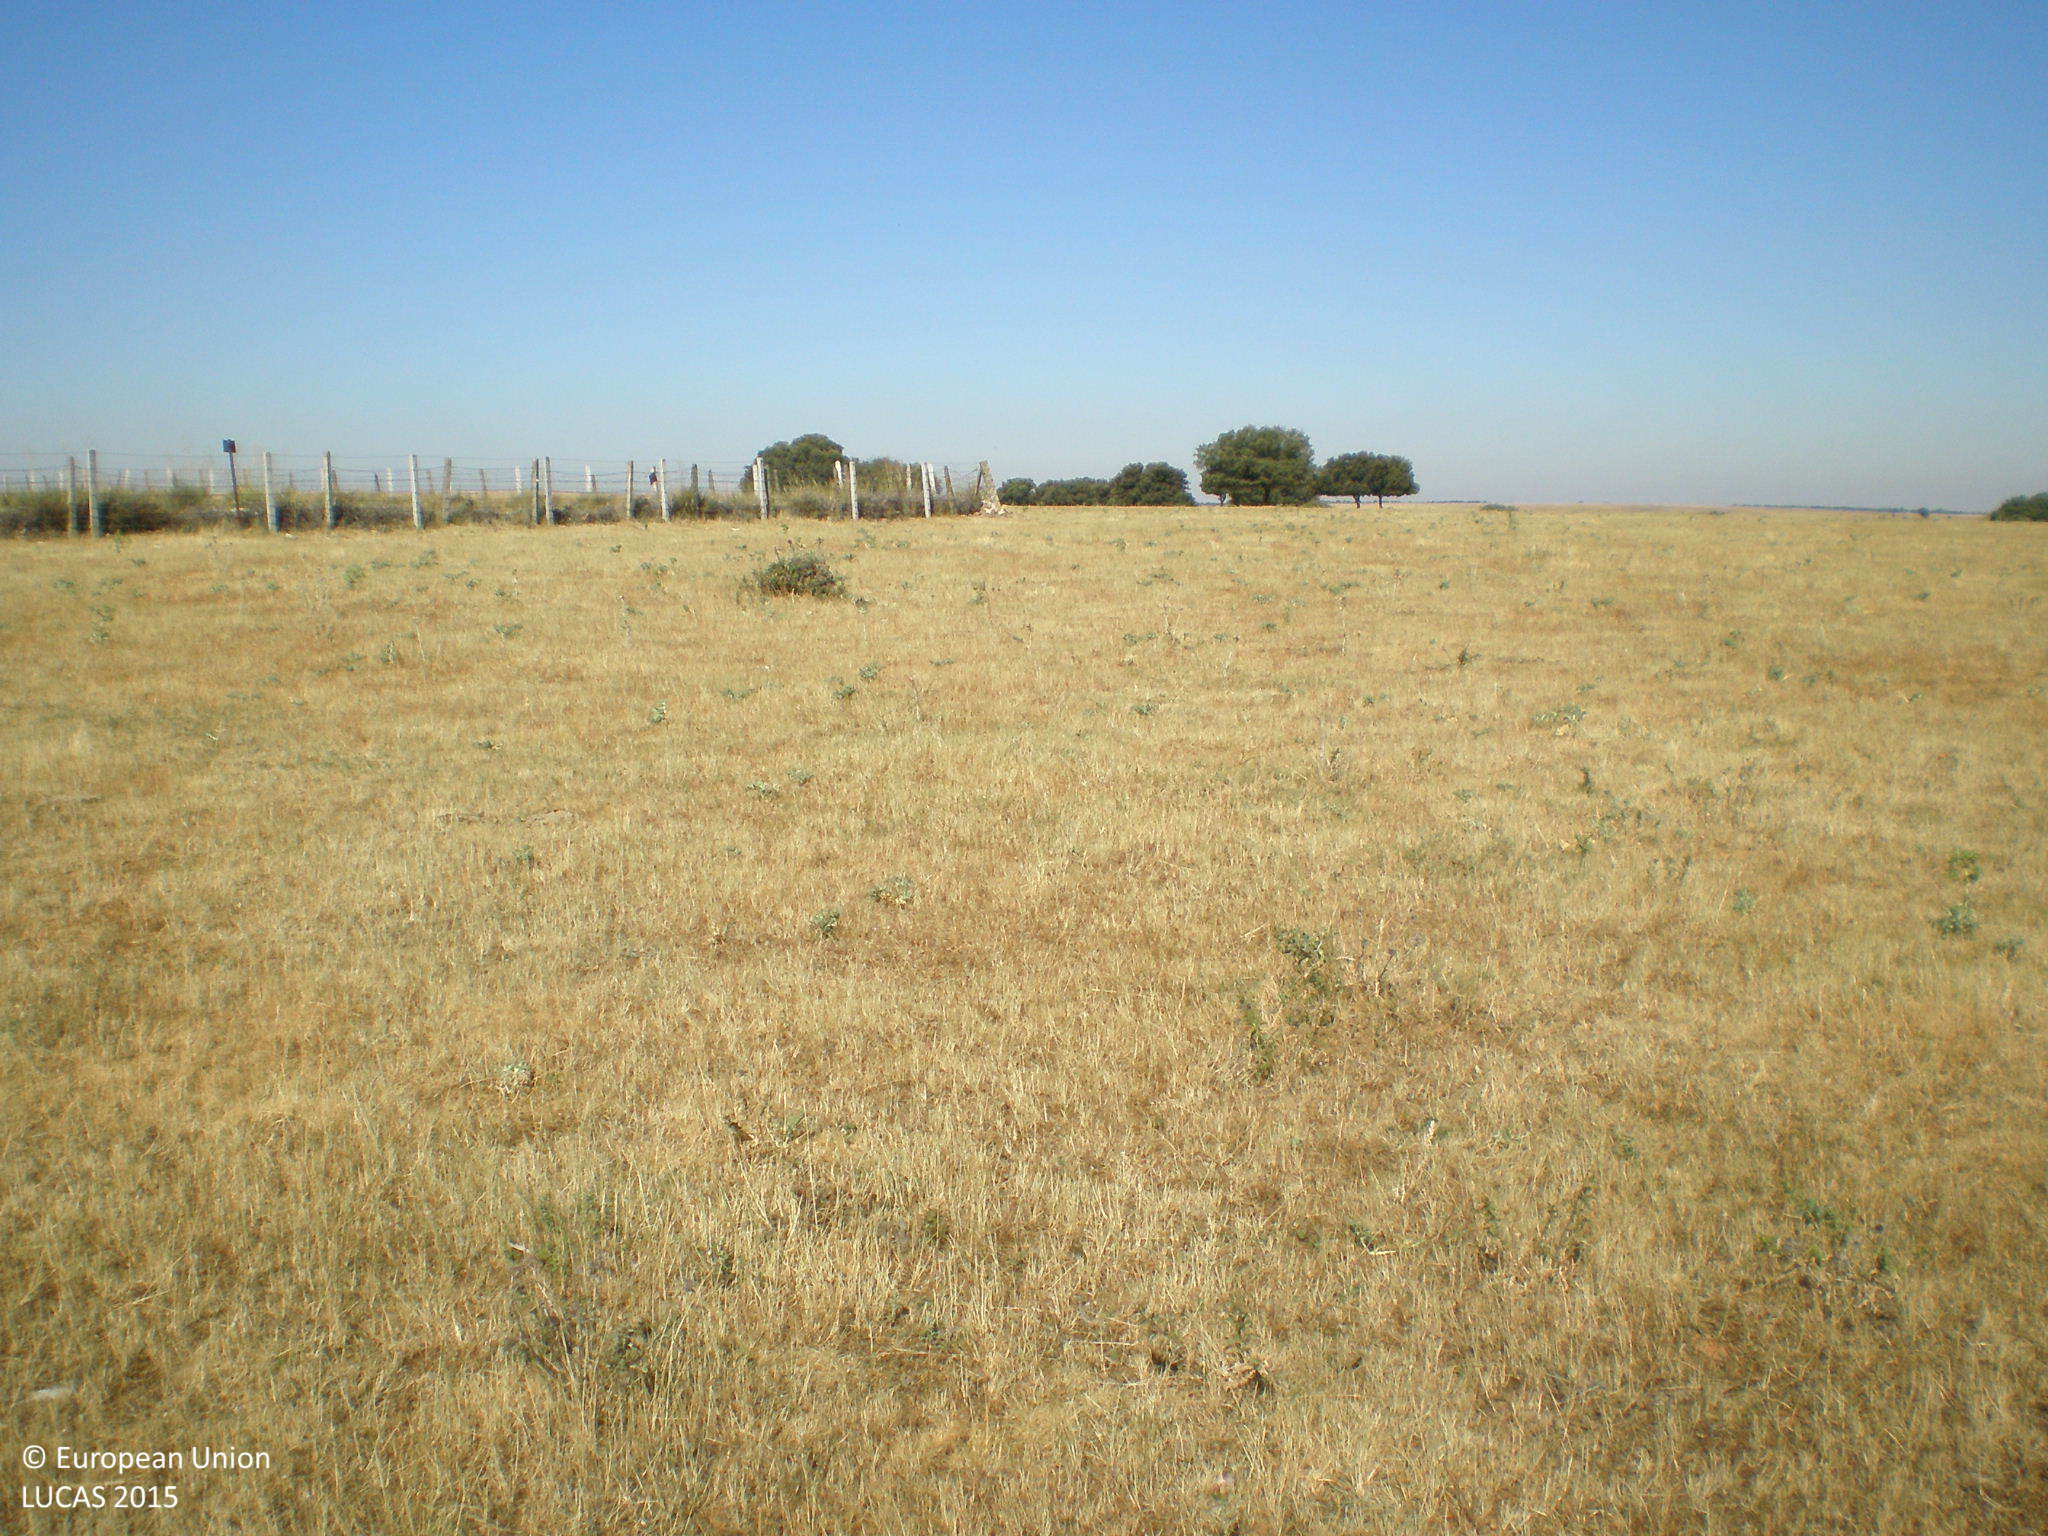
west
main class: Grassland
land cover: Grassland without tree/shrub cover
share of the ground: > 75 %
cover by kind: herbaceous plants 100 %
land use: Agriculture (excluding fallow land and kitchen gardens)
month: June
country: ES
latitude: 40.8125
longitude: -5.7127
